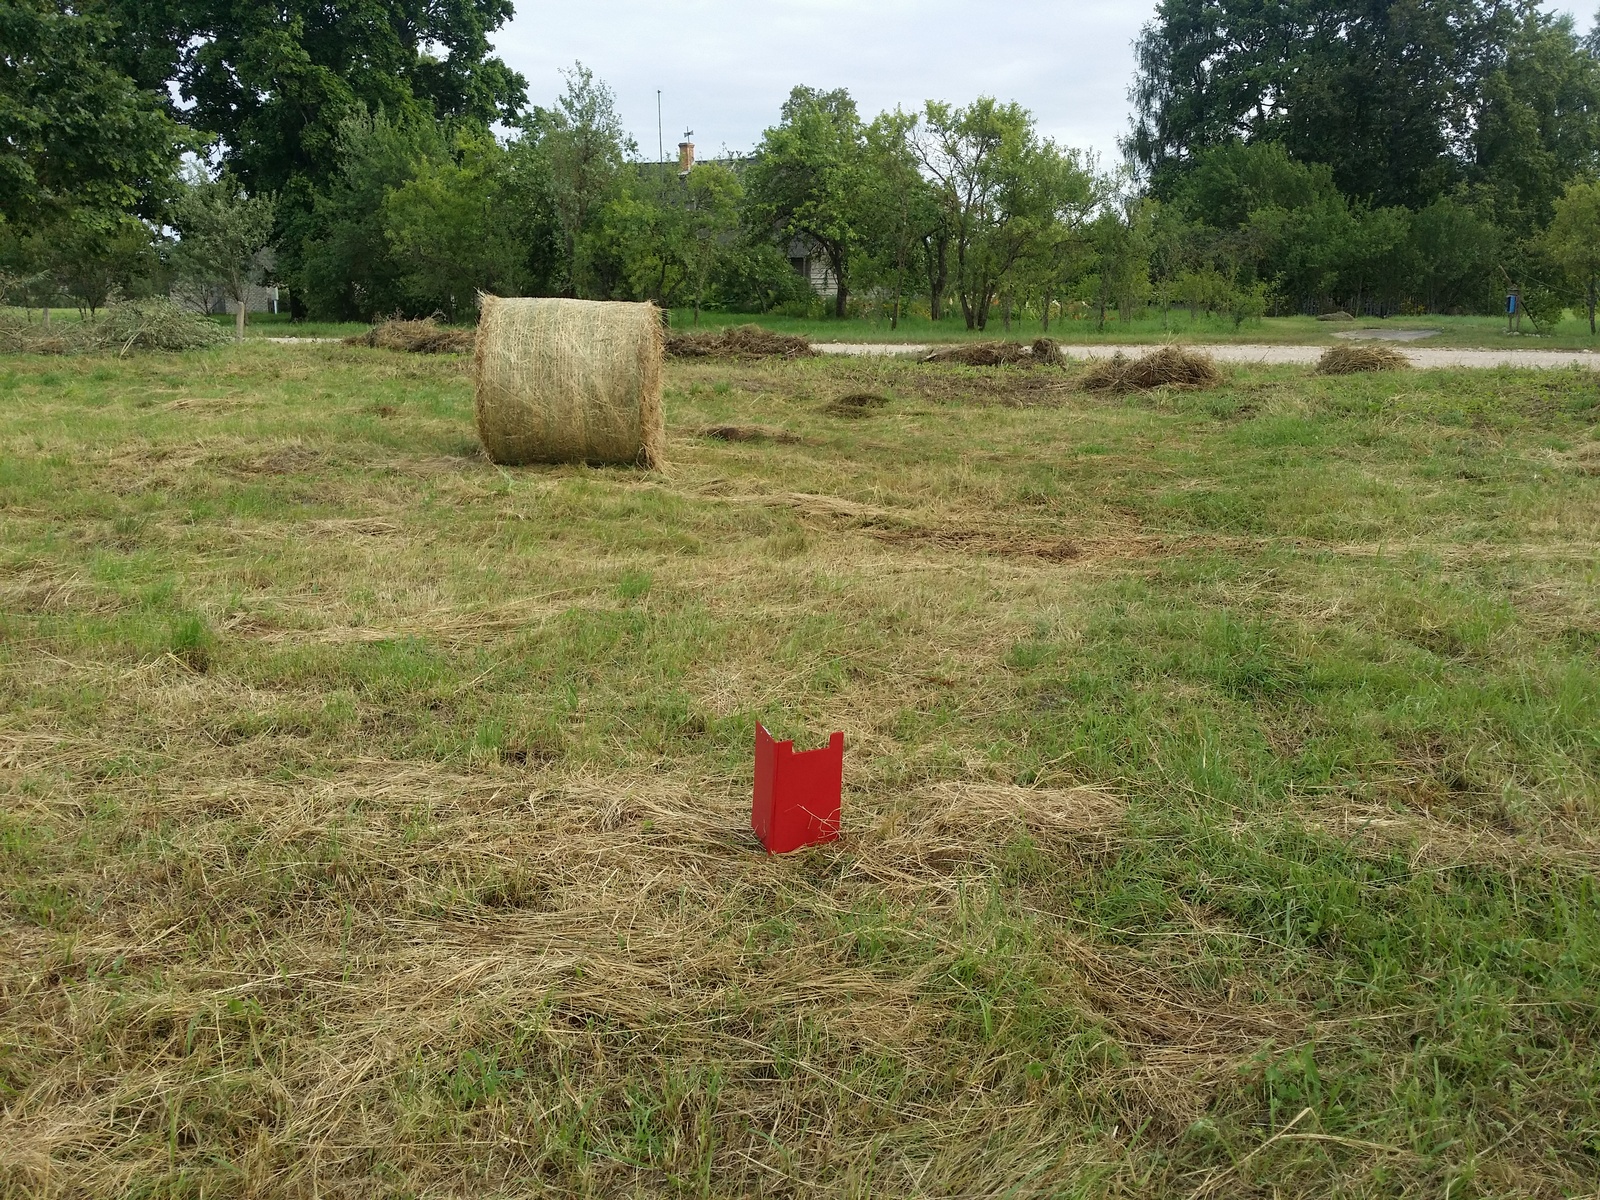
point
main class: Grassland
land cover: Grassland without tree/shrub cover
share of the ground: > 75 %
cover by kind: herbaceous plants 90 %, unconsolidated bare surface 10 %
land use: Agriculture (excluding fallow land and kitchen gardens)
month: August
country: LV
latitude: 56.9474
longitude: 27.2155
